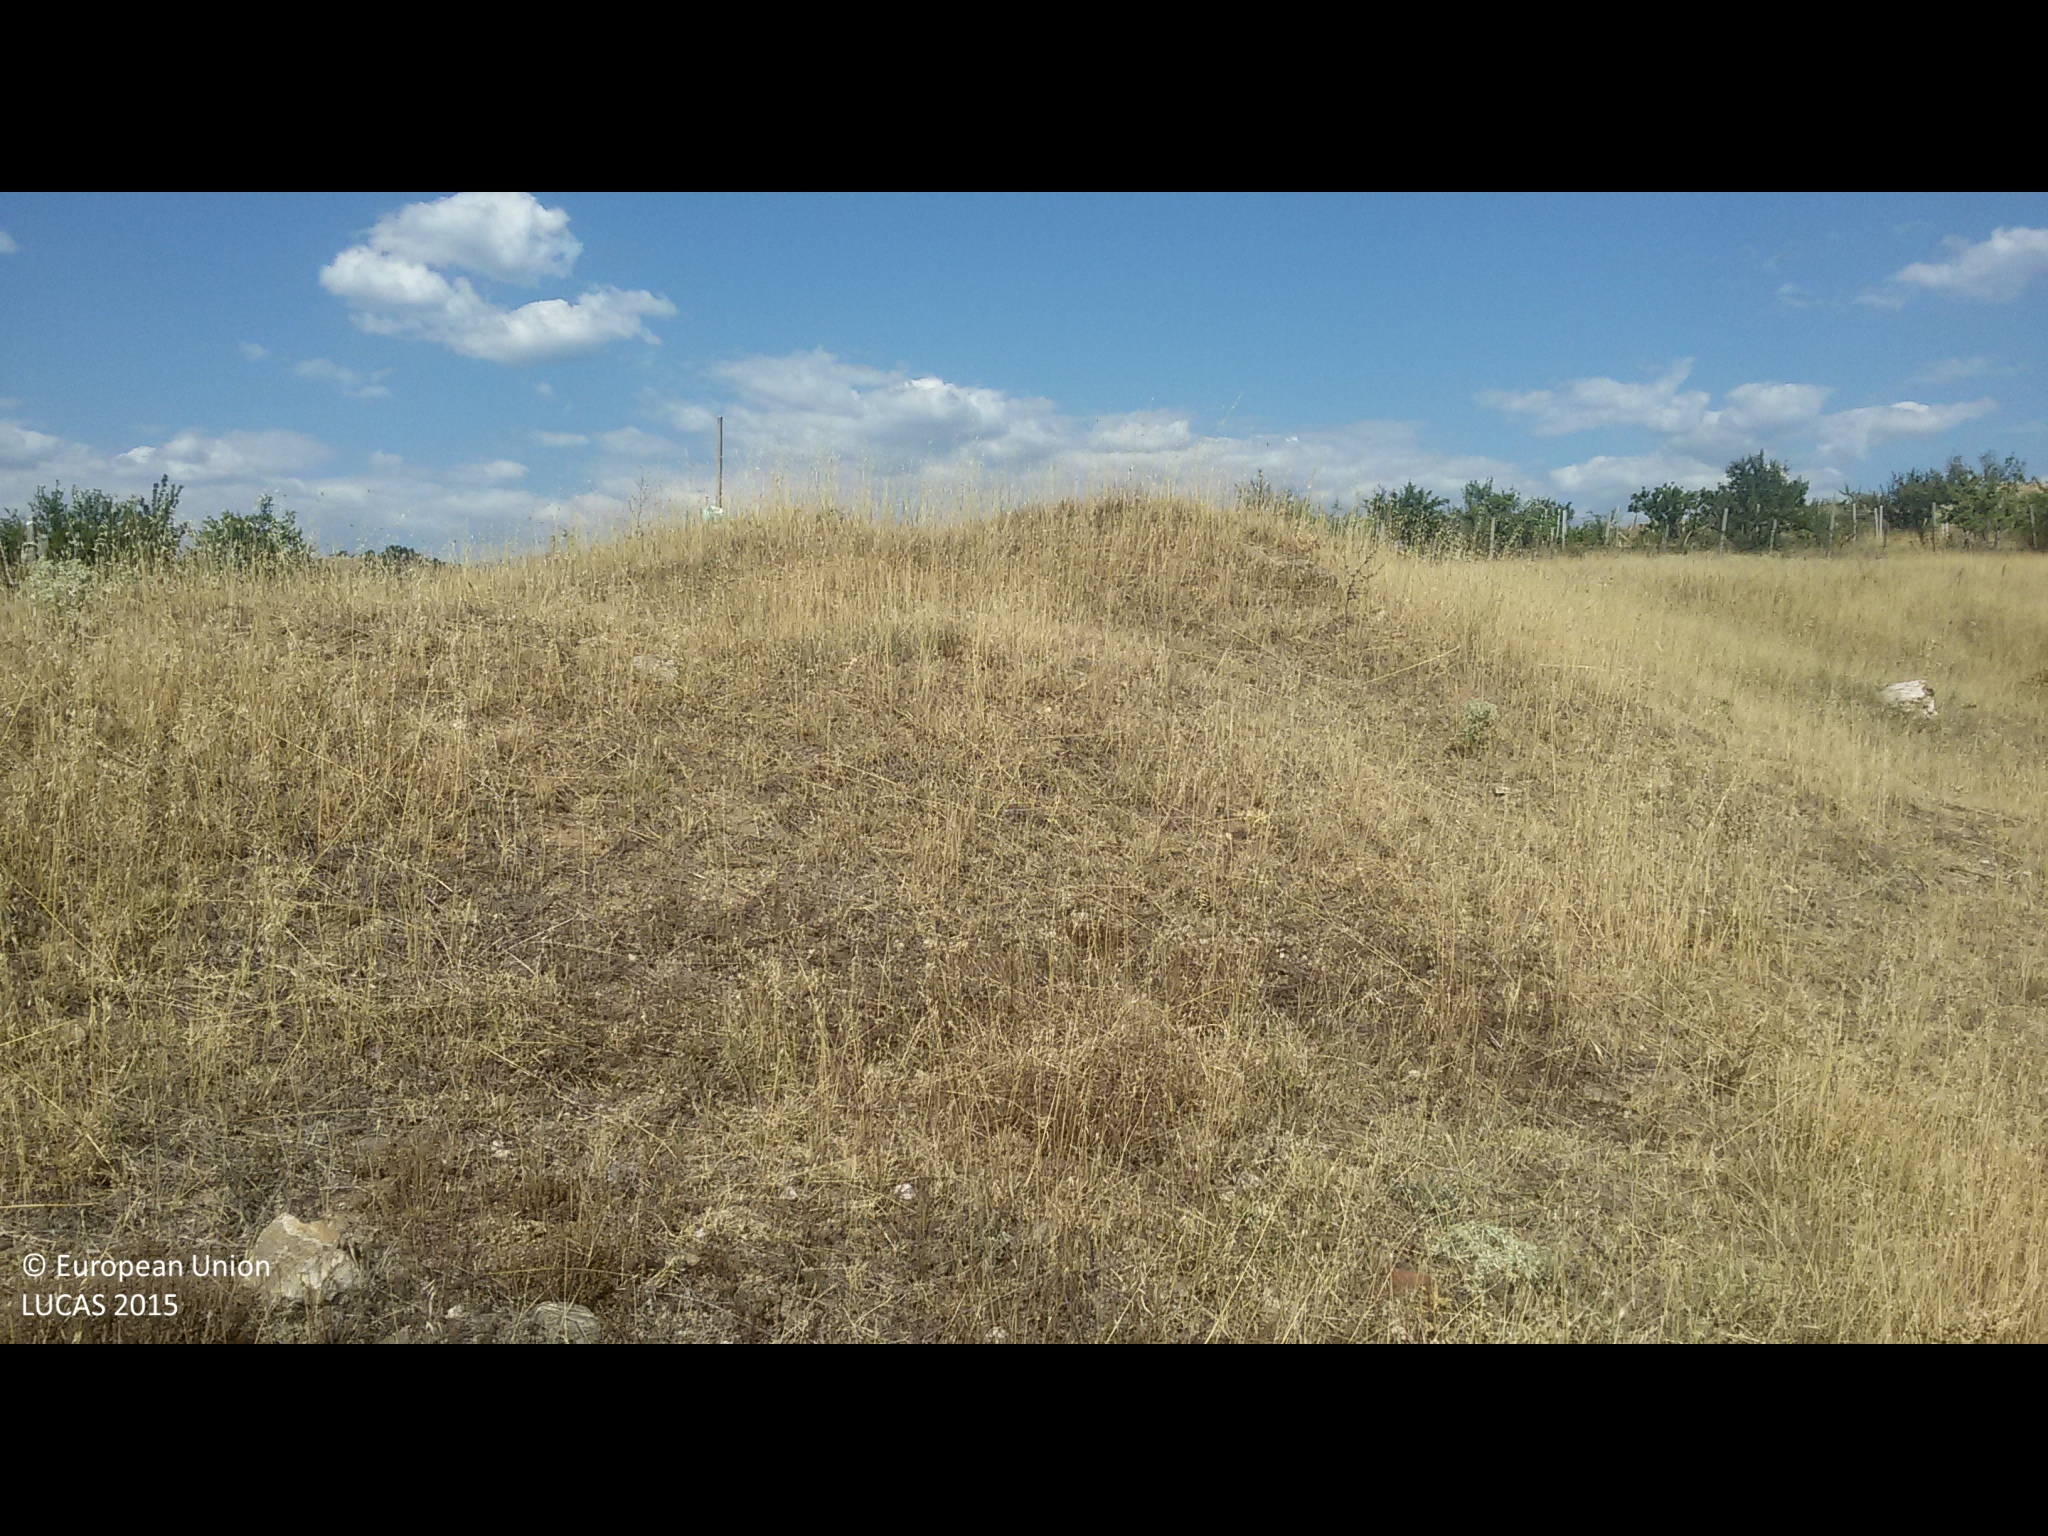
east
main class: Grassland
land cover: Grassland without tree/shrub cover
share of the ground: > 75 %
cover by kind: herbaceous plants 95 %, shrubs 5 %
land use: Agriculture (excluding fallow land and kitchen gardens)
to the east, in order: Grassland without tree/shrub cover; Fences; Apple fruit; Fences; Grassland without tree/shrub cover; Paved roads, cycling and walking lanes; Grass margins; Fences; Pear fruit; Fences; Grassland with sparse tree/shrub cover; Grassland without tree/shrub cover; Single bushes/trees; Grassland with sparse tree/shrub cover; Broadleaved woodland; Tracks; Broadleaved woodland
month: August
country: BG
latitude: 41.9972
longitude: 23.1228
